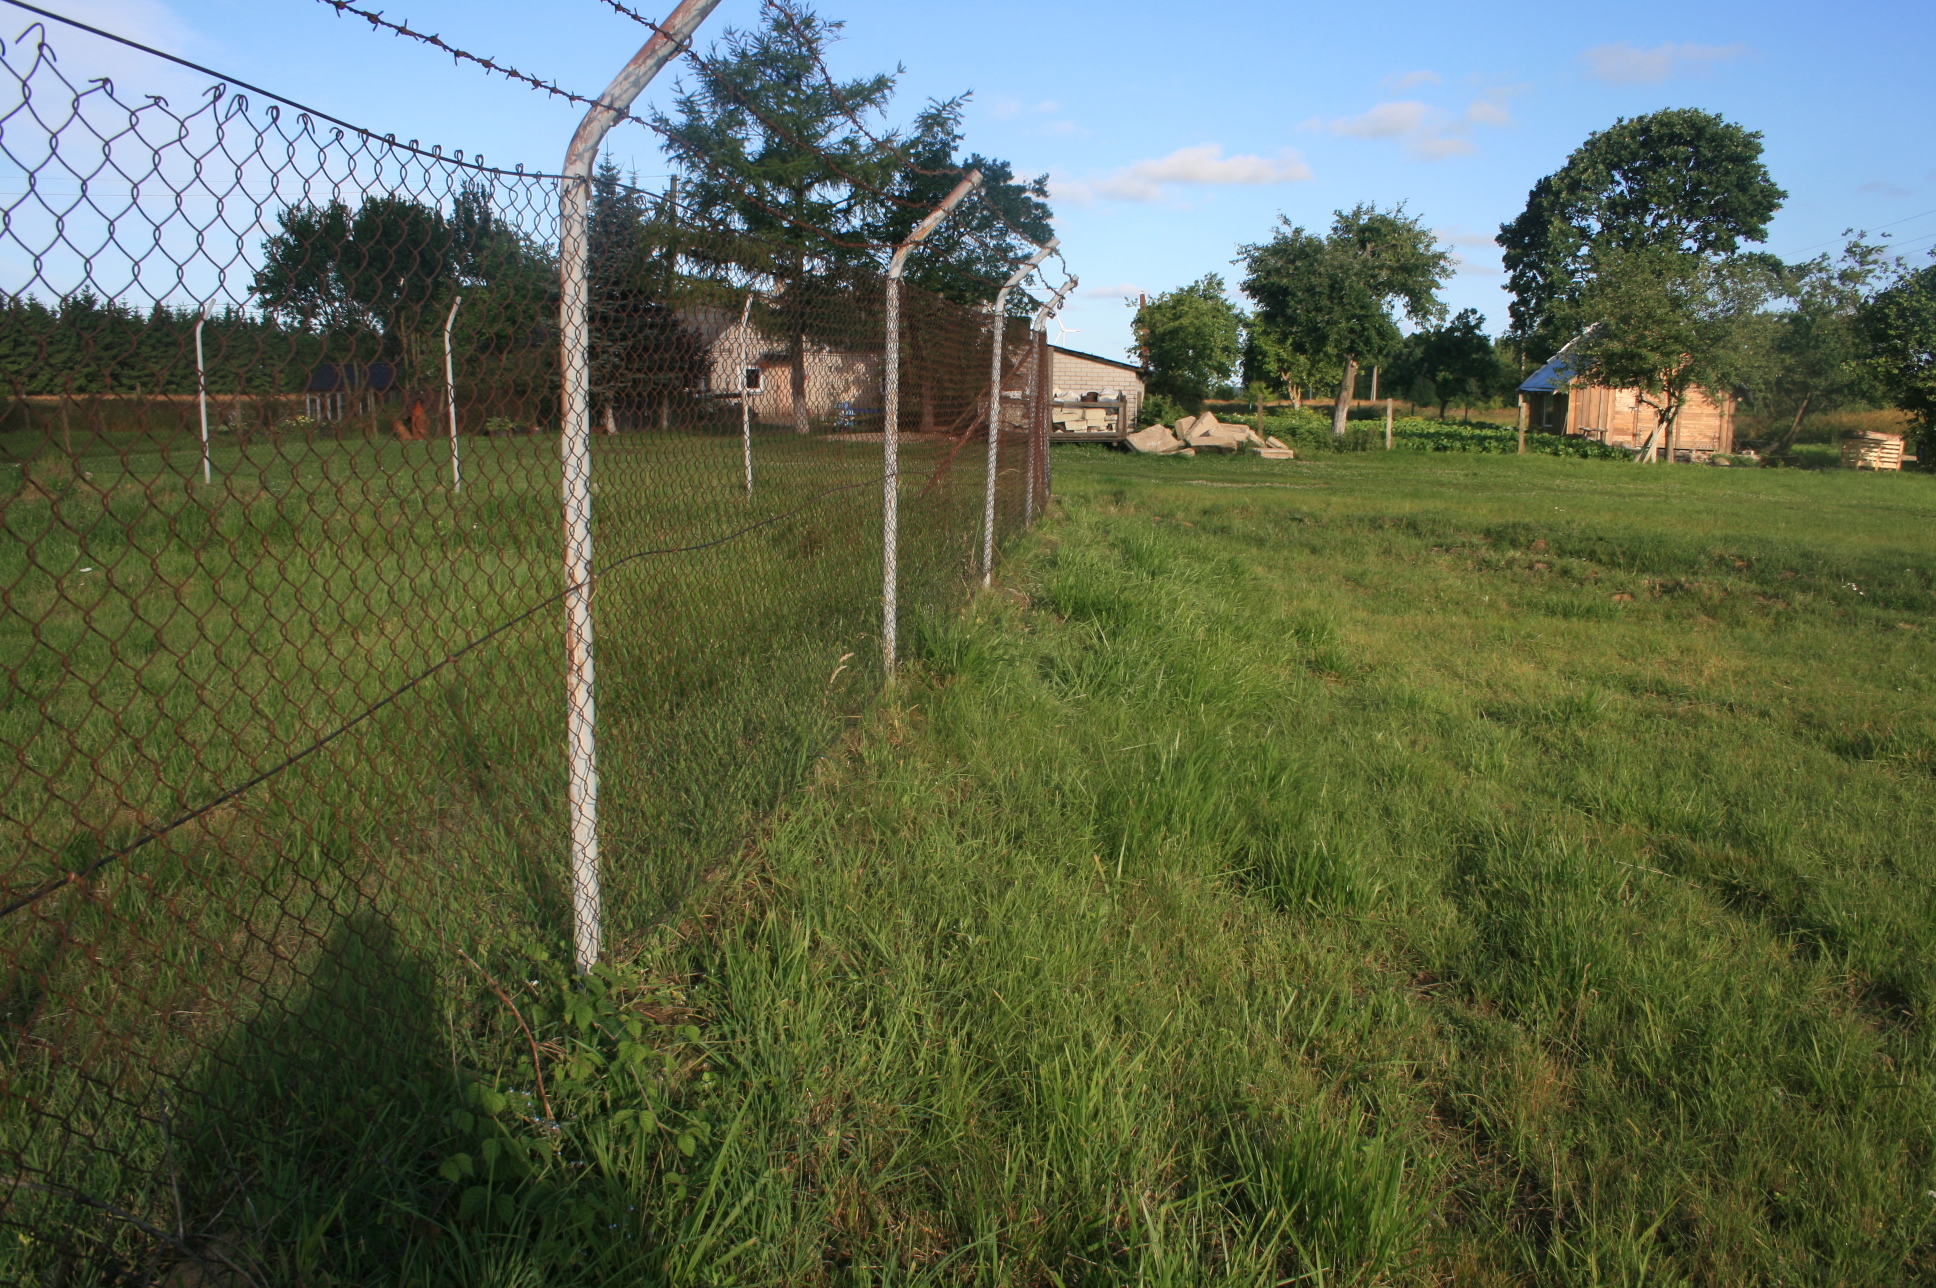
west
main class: Grassland
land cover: Grassland without tree/shrub cover
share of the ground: > 75 %
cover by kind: herbaceous plants 80 %, unconsolidated bare surface 20 %
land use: Transport via pipelines
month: July
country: LT
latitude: 55.8763
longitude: 21.2133
